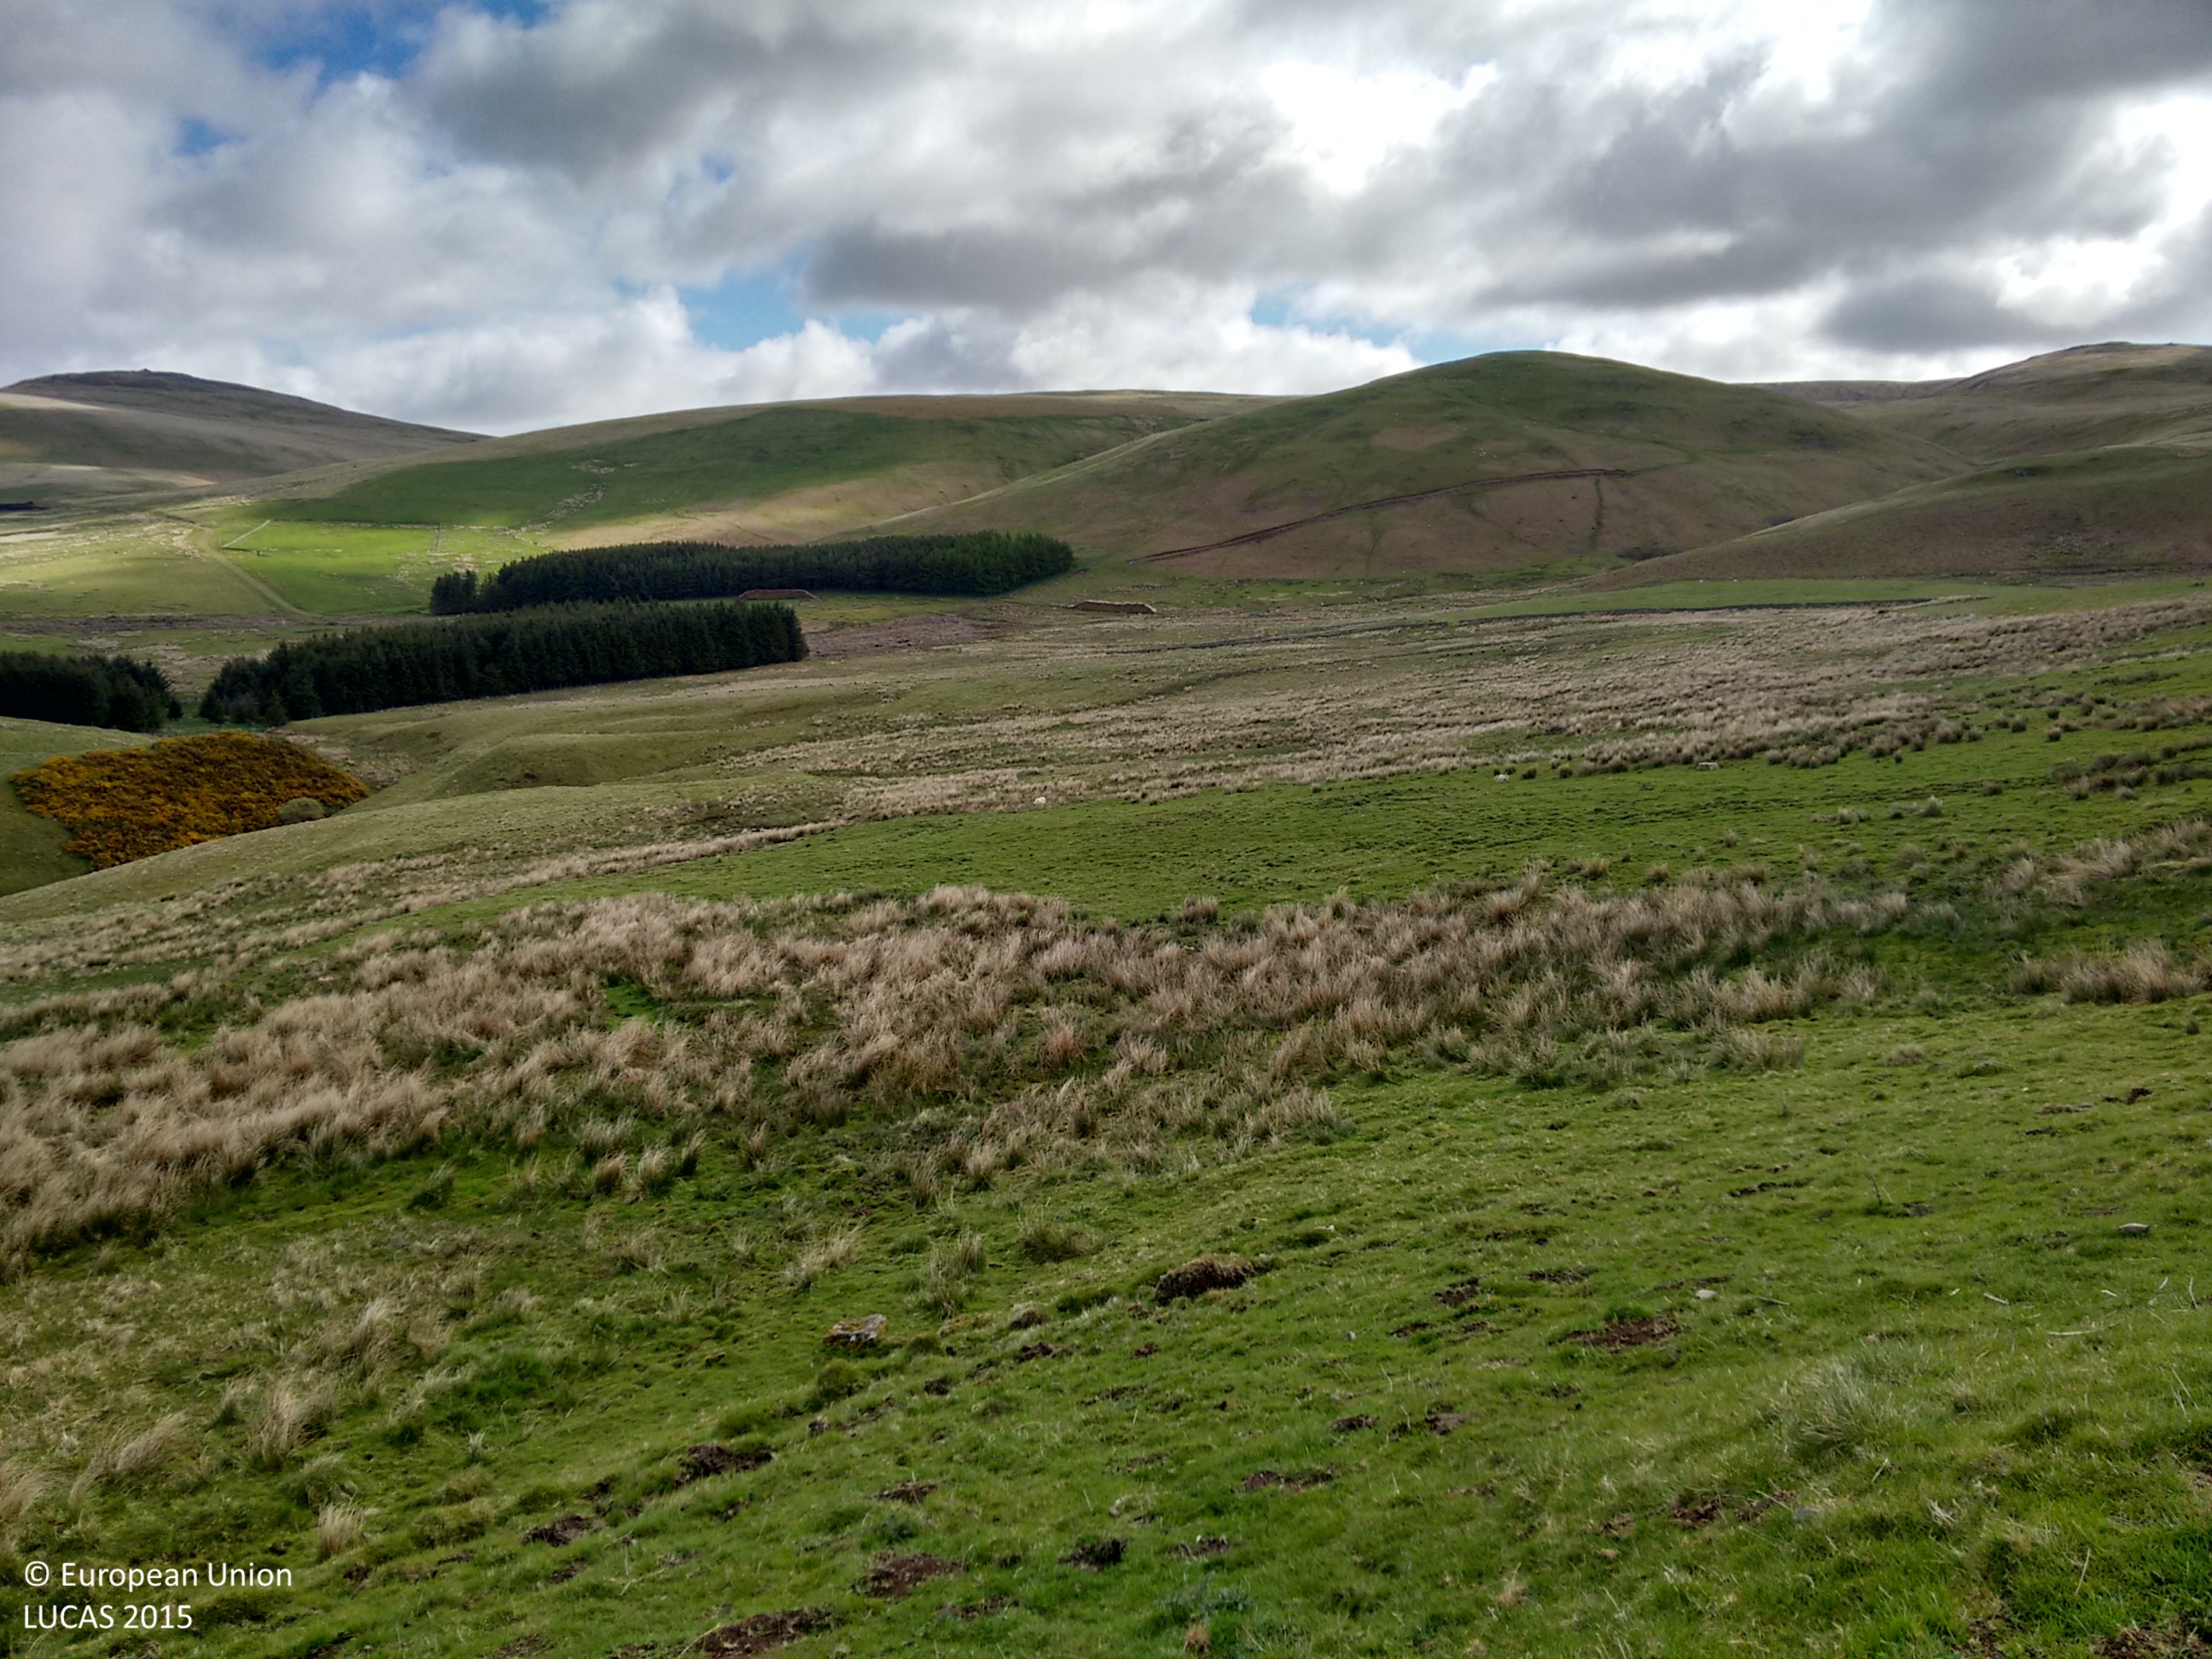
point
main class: Grassland
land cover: Grassland without tree/shrub cover
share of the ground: > 75 %
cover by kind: herbaceous plants 100 %
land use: Agriculture (excluding fallow land and kitchen gardens)
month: May
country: GB
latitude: 55.4734
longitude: -2.2222
